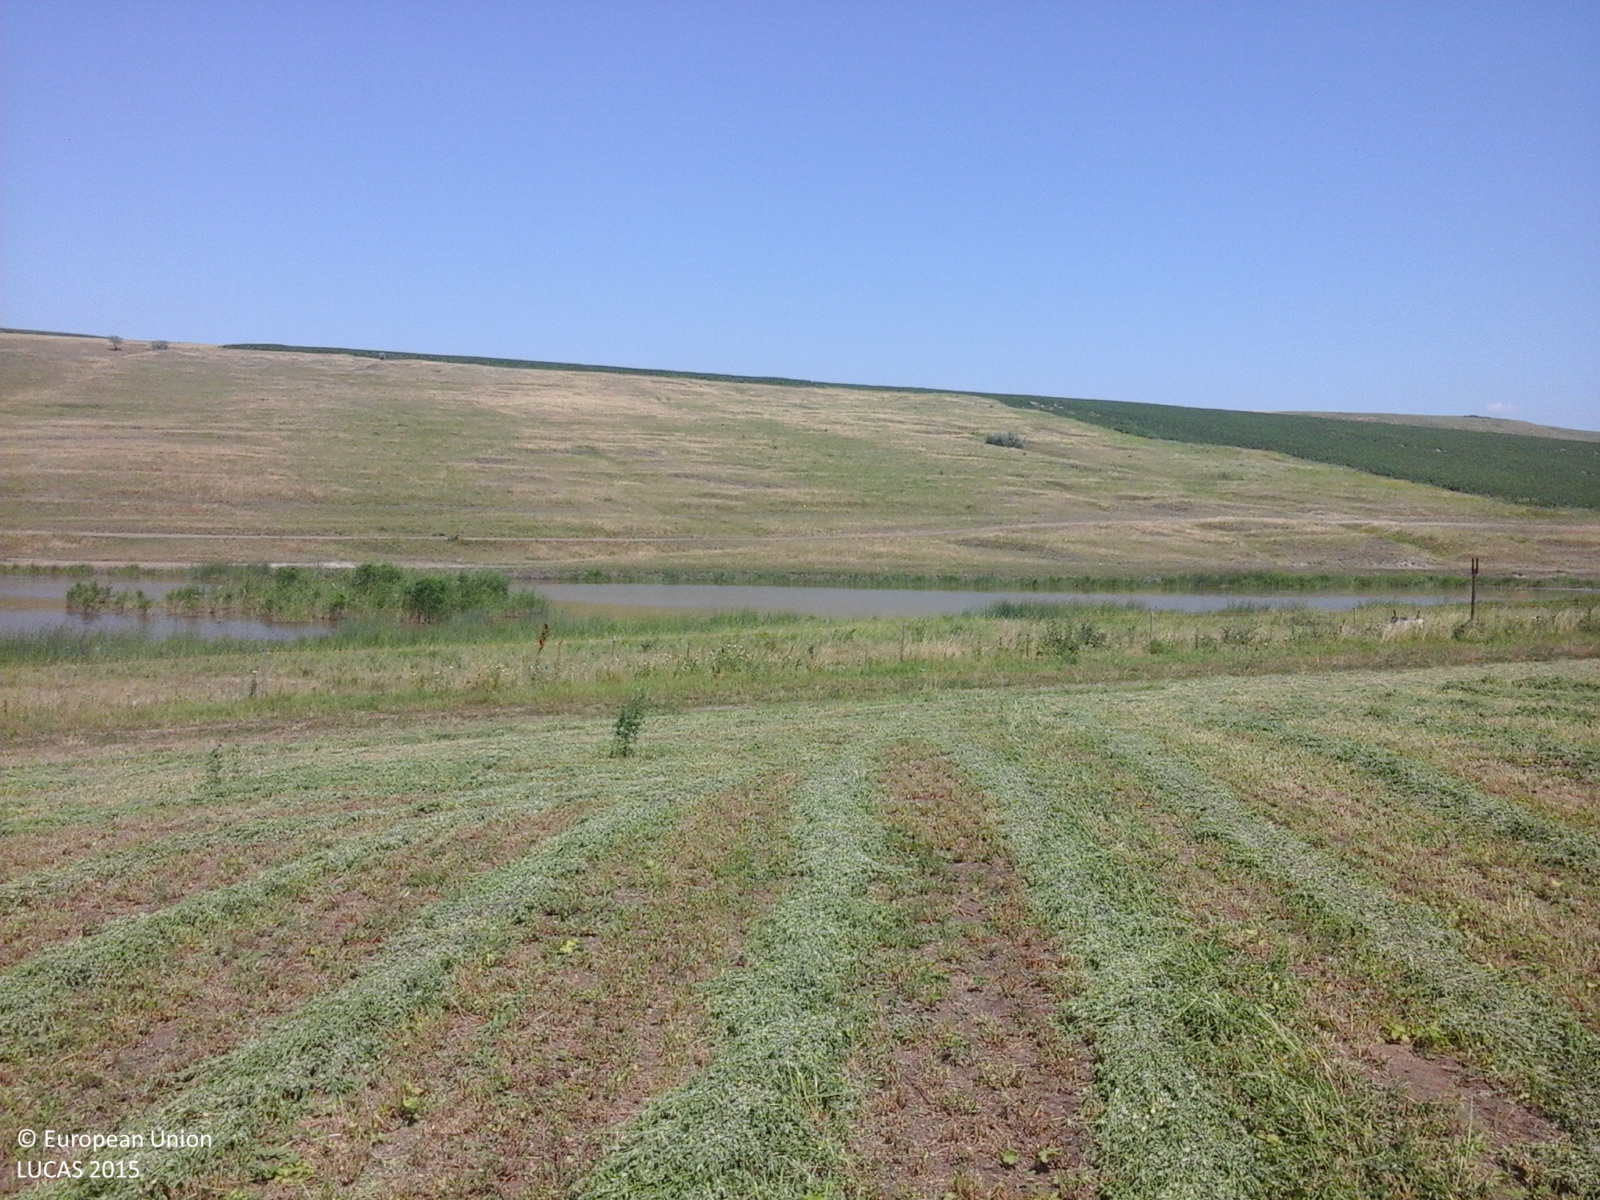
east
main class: Cropland
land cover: Lucerne
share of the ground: 10 - 25 %
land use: Agriculture (excluding fallow land and kitchen gardens)
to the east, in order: Lucerne; Tracks; Grassland without tree/shrub cover; Inland fresh water bodies; Grassland without tree/shrub cover; Tracks; Grassland without tree/shrub cover
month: June
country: RO
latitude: 47.3081
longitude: 27.3745
